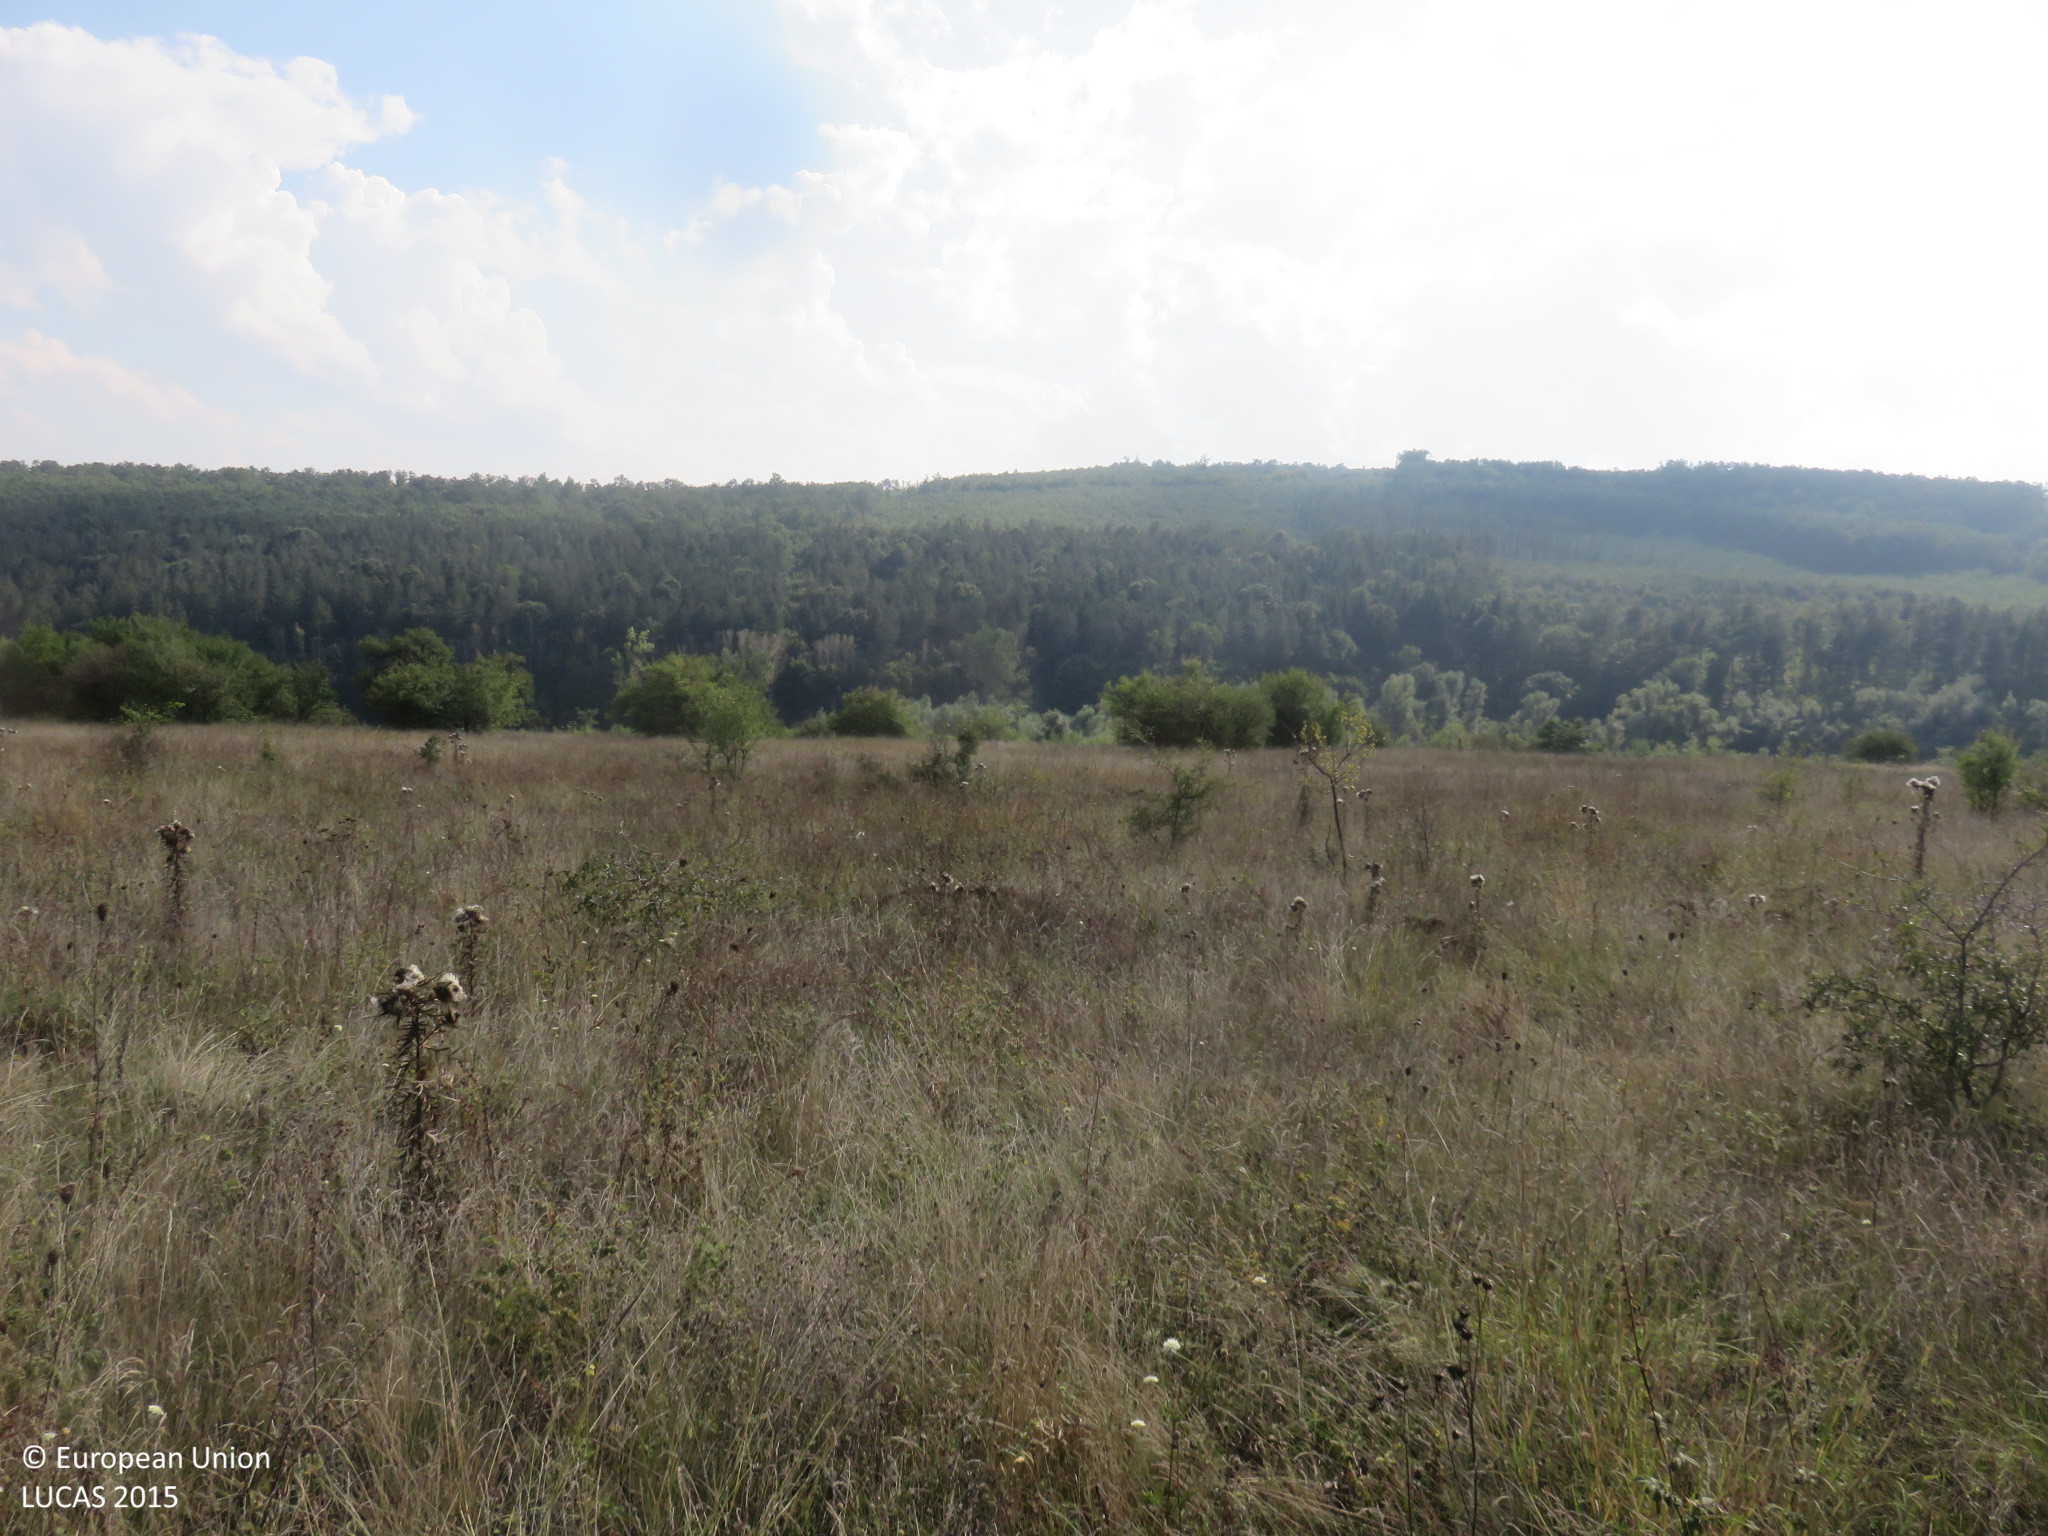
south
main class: Grassland
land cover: Grassland with sparse tree/shrub cover
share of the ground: > 75 %
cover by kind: herbaceous plants 90 %, broadleaved forest trees 5 %, shrubs 5 %
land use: Fallow land
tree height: < 5 m
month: September
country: BG
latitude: 43.1561
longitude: 25.0348
